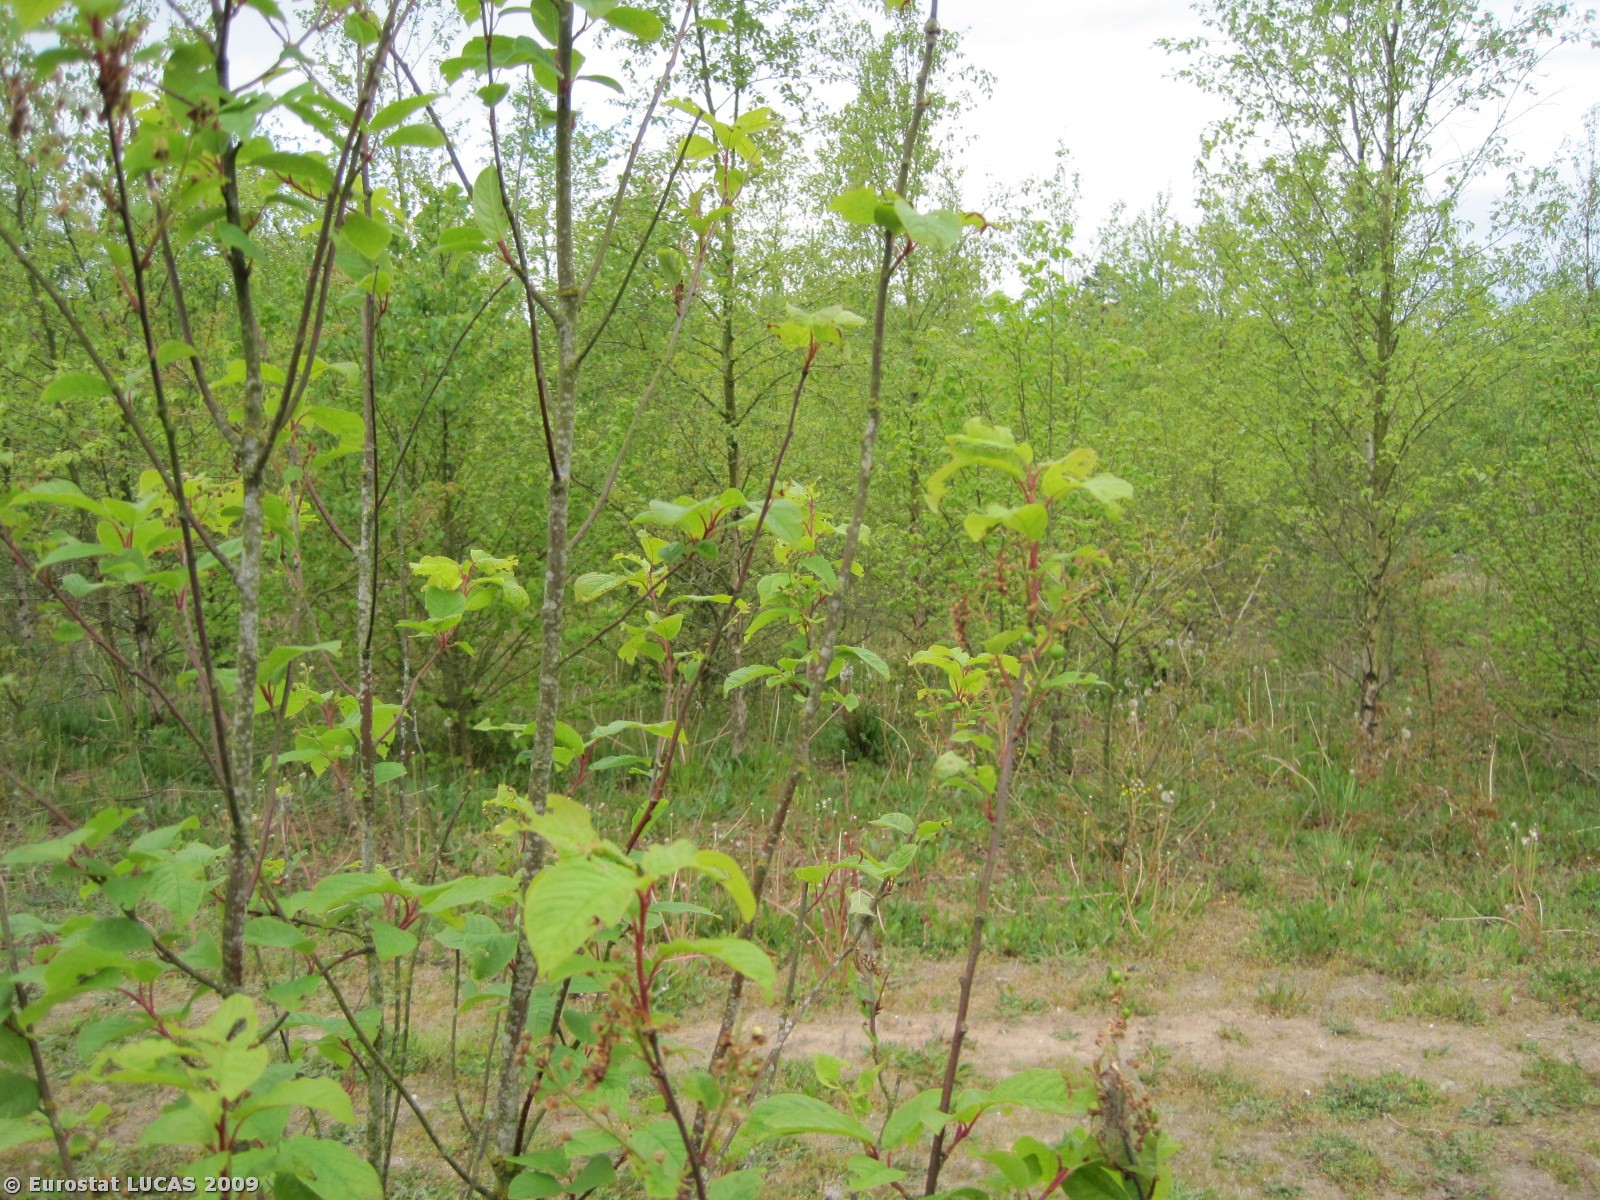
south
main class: Woodland
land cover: Broadleaved woodland
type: plantations and self-sown exotic forest
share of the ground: > 75 %
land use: Forestry
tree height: > 5 m
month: May
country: DK
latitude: 56.7270
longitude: 9.9837
